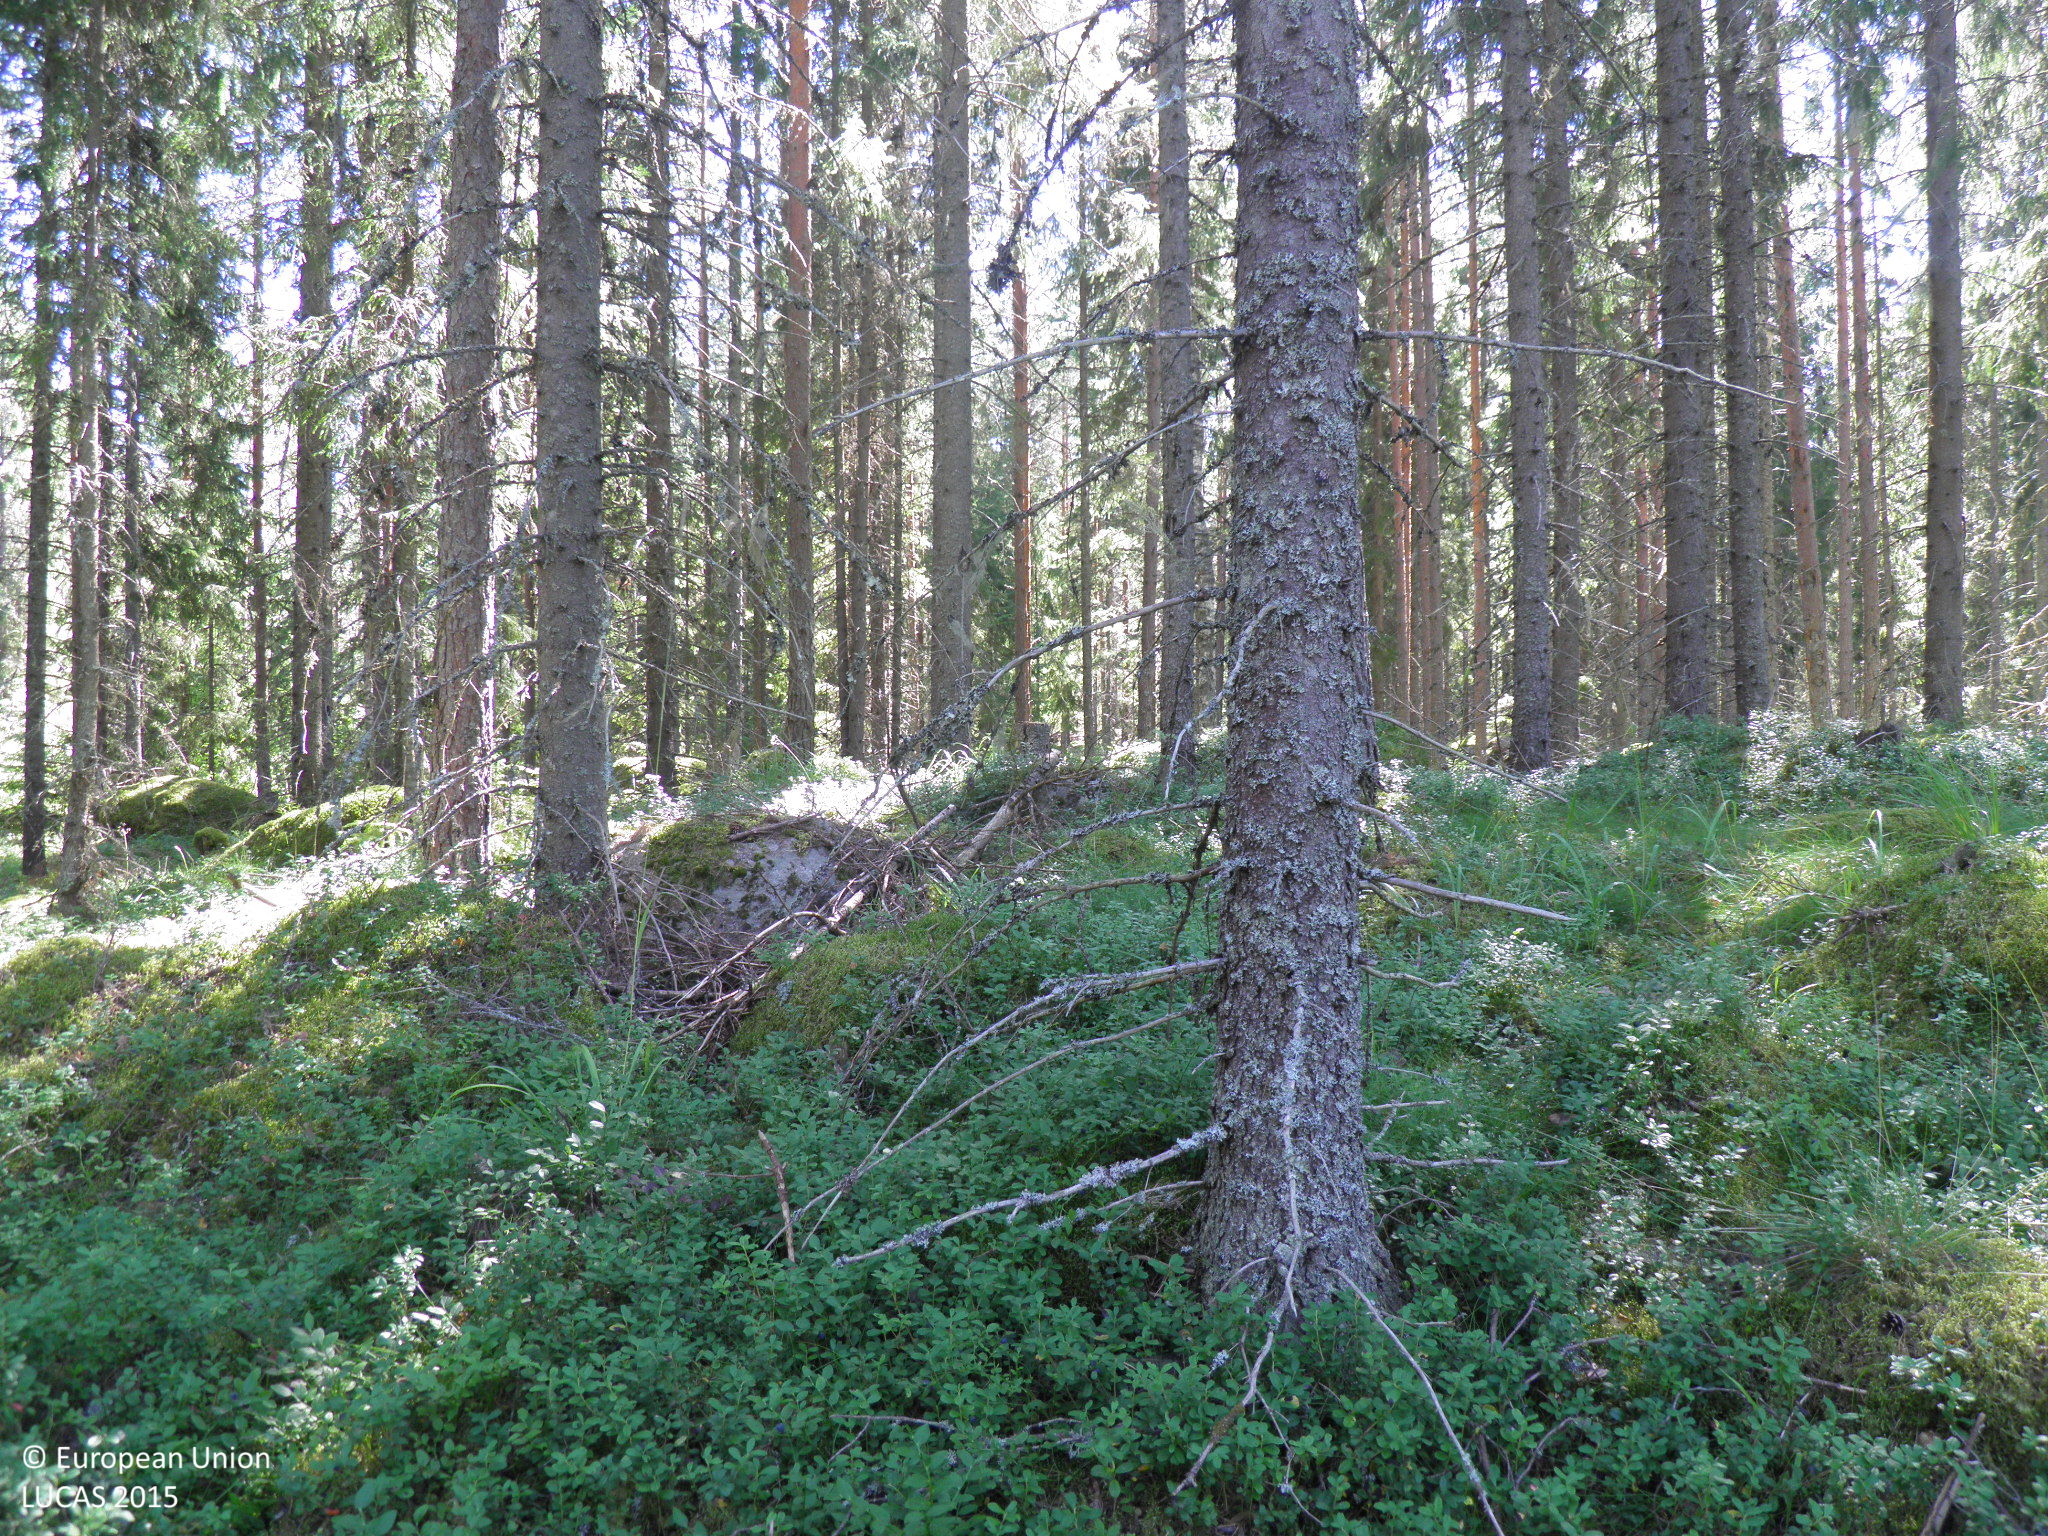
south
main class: Woodland
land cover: Other coniferous woodland
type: hemiboreal forest and nemoral coniferous forest and mixed broadleaved-coniferous forest
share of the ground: 50 - 75 %
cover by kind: coniferous forest trees 50 %, shrubs 20 %, herbaceous plants 20 %, broadleaved forest trees 10 %
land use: Forestry
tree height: > 5 m
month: August
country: FI
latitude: 60.7570
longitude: 22.0453
